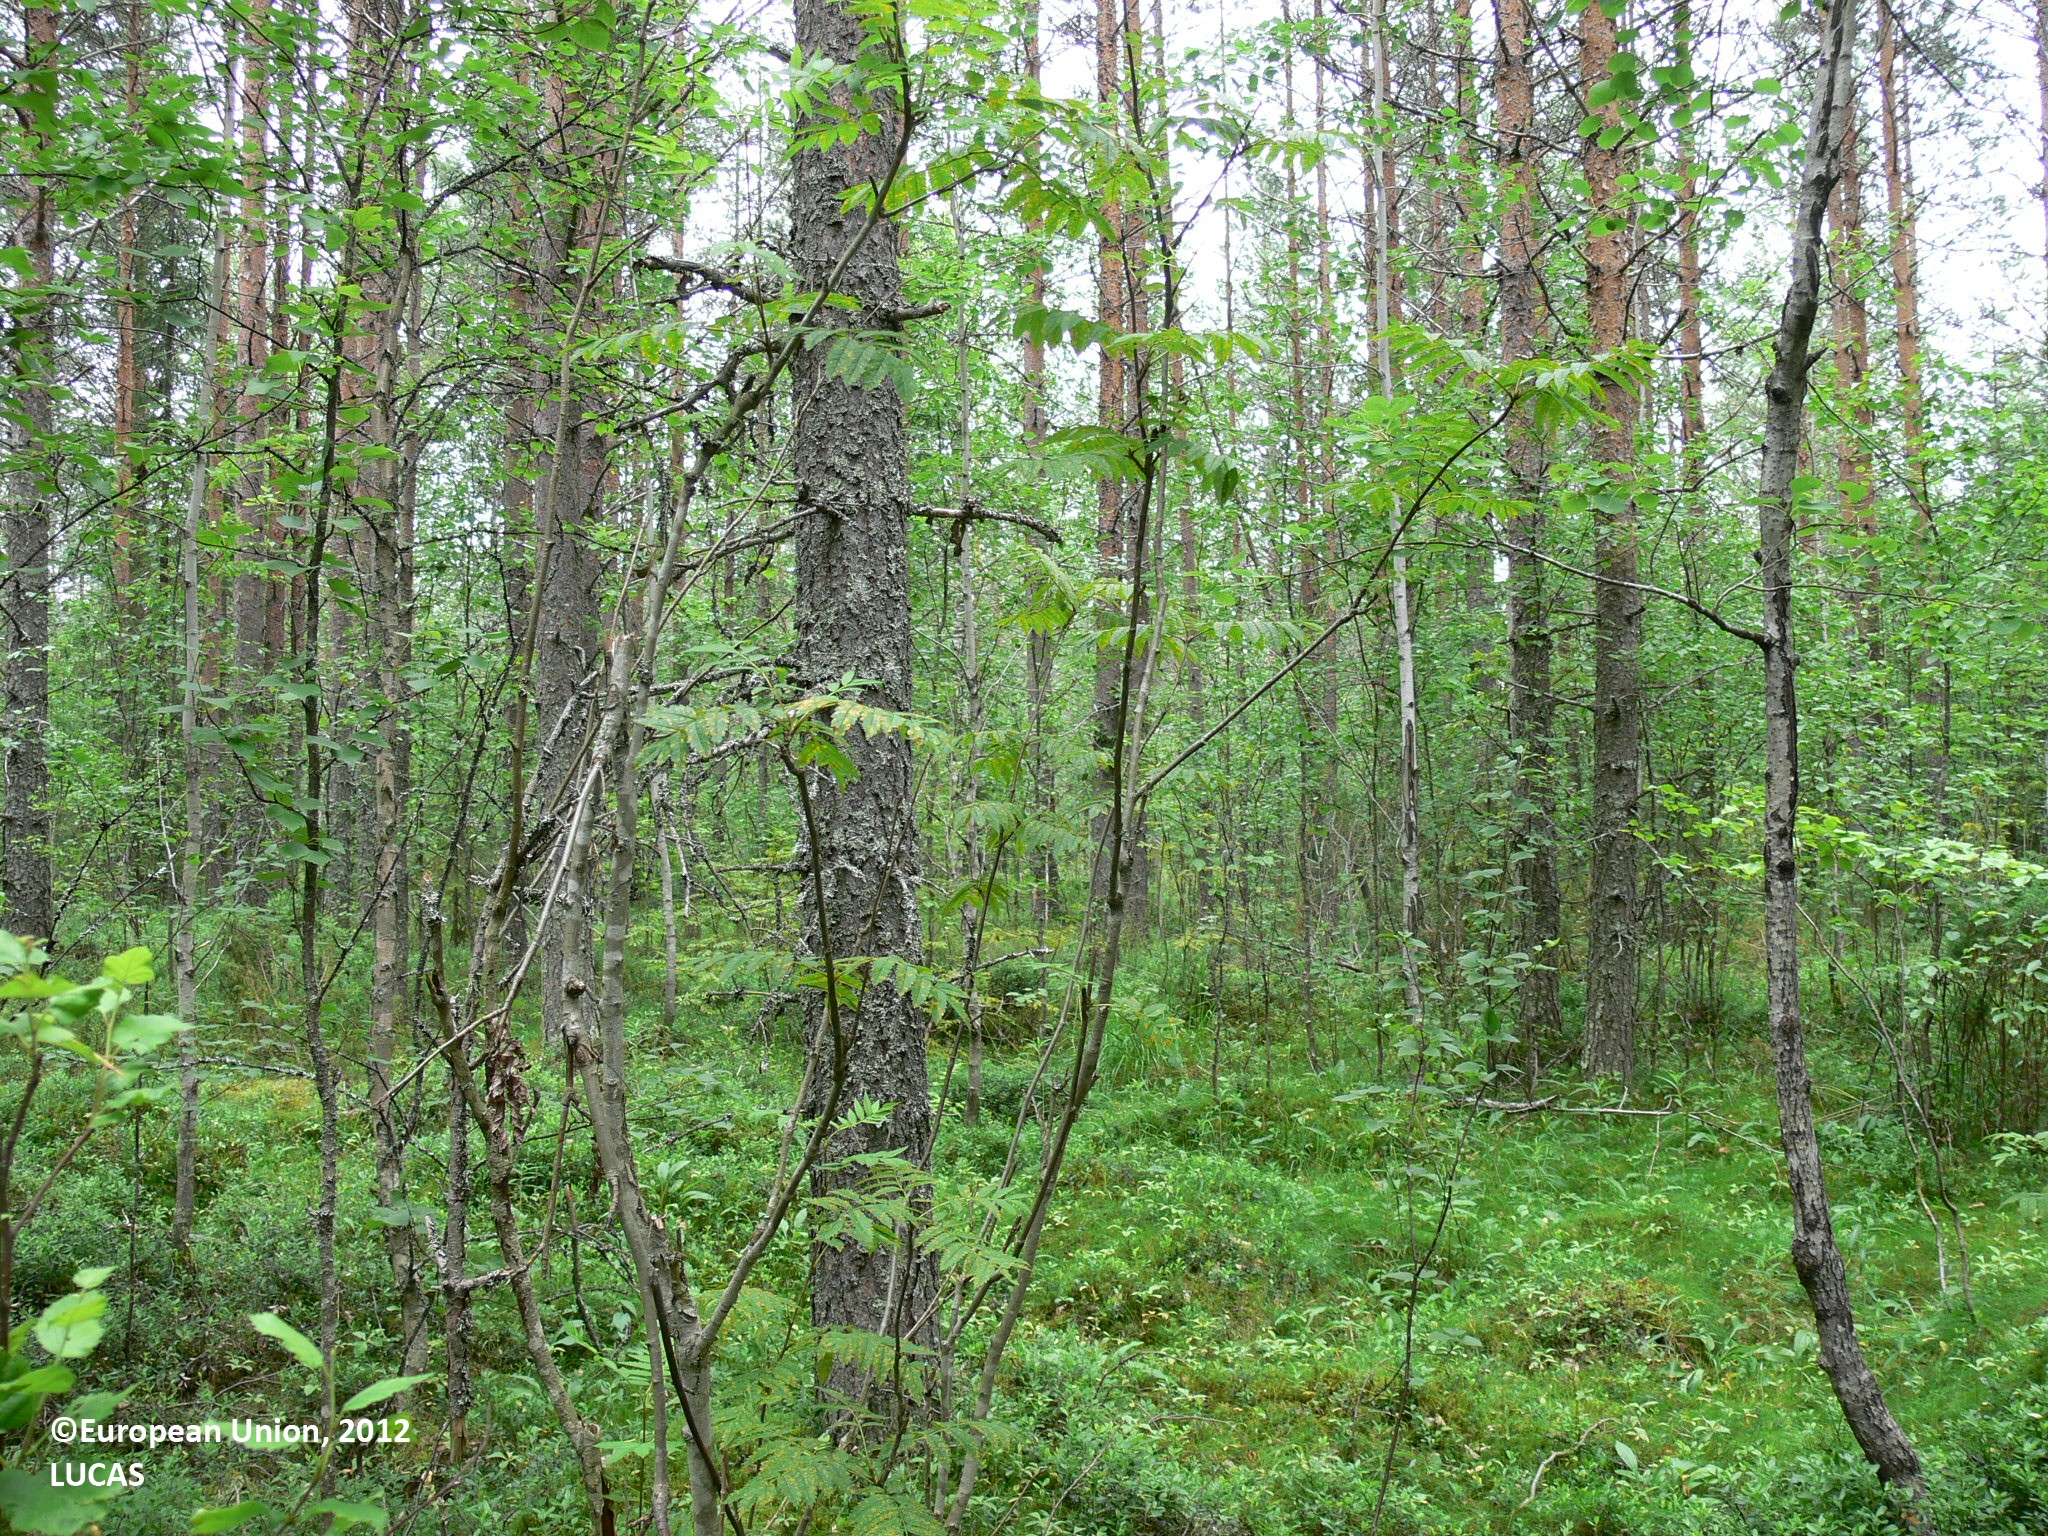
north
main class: Woodland
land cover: Other mixed woodland
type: boreal forest
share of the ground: > 75 %
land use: Forestry
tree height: > 5 m
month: July
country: FI
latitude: 63.2288
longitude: 30.7202
